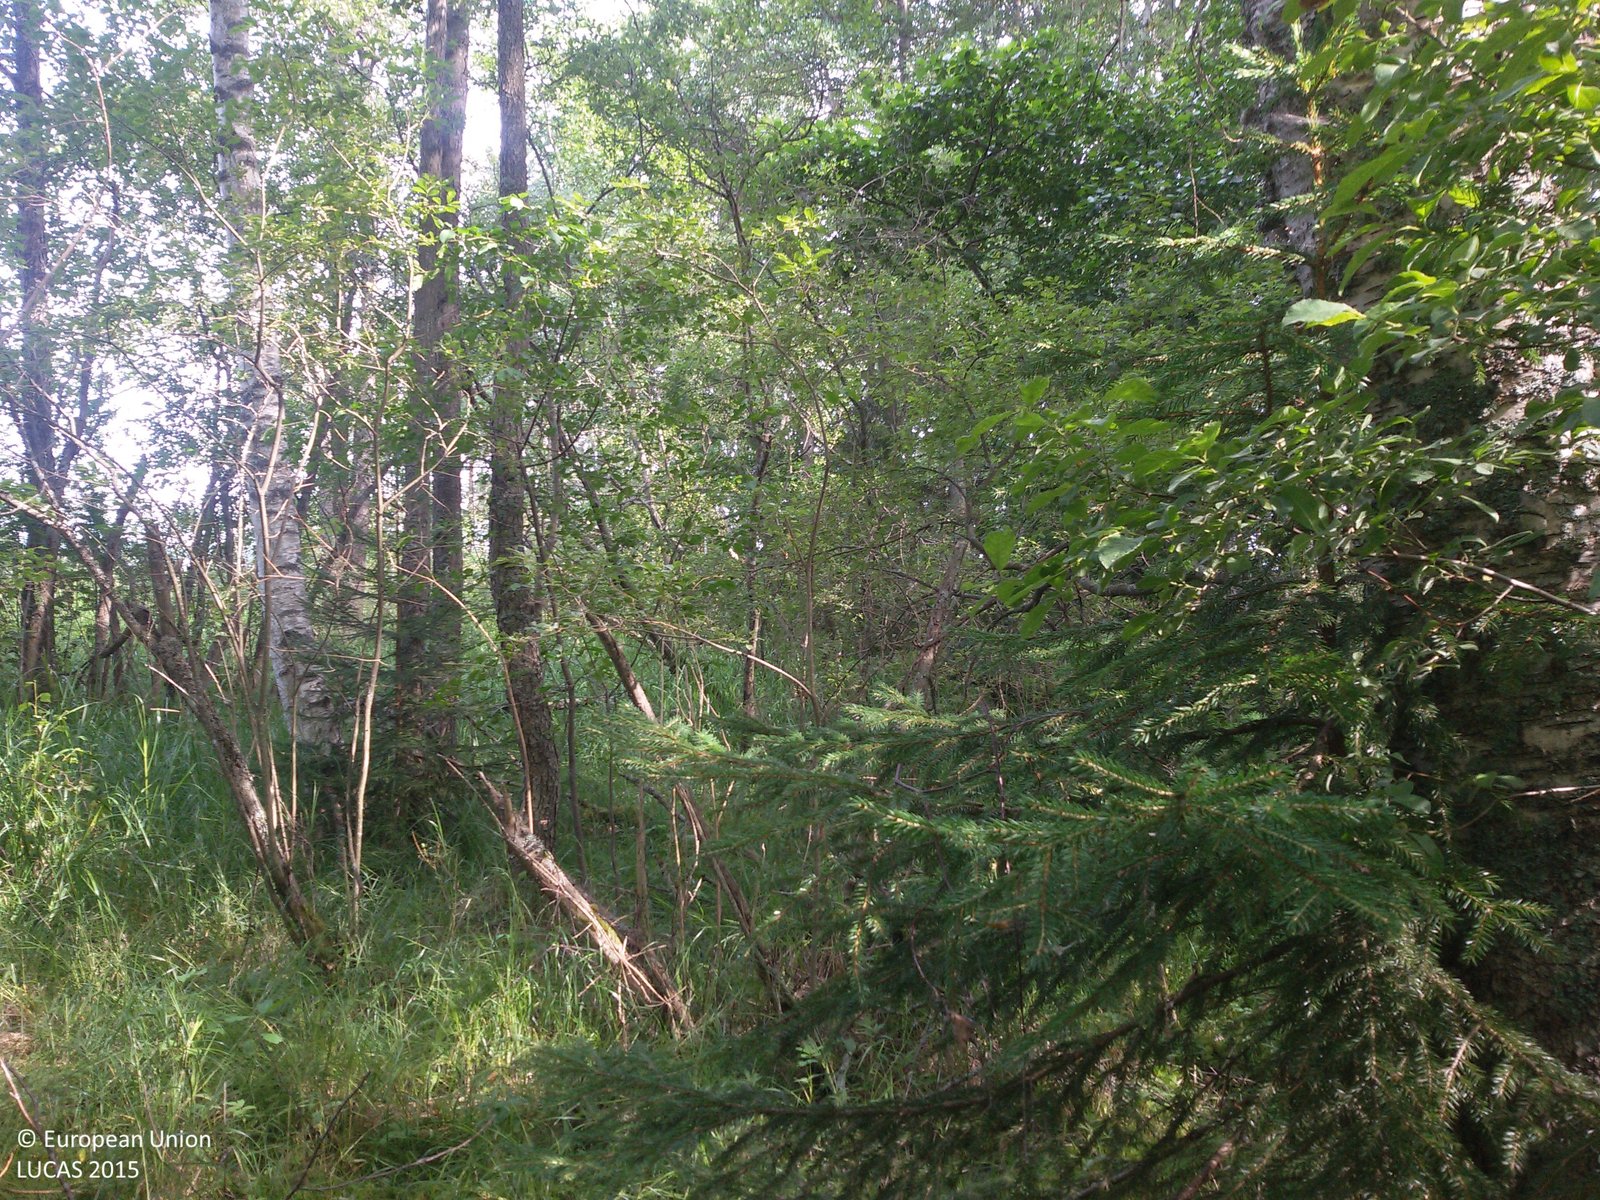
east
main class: Woodland
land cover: Pine dominated mixed woodland
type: hemiboreal forest and nemoral coniferous forest and mixed broadleaved-coniferous forest
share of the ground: > 75 %
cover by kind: broadleaved forest trees 60 %, coniferous forest trees 25 %, herbaceous plants 10 %, lichens and mosses 5 %
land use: Semi-natural and natural areas not in use
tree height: > 5 m
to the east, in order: Pine dominated mixed woodland; Broadleaved woodland; Inland fresh water bodies
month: August
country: SE
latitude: 60.4767
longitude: 16.6291
